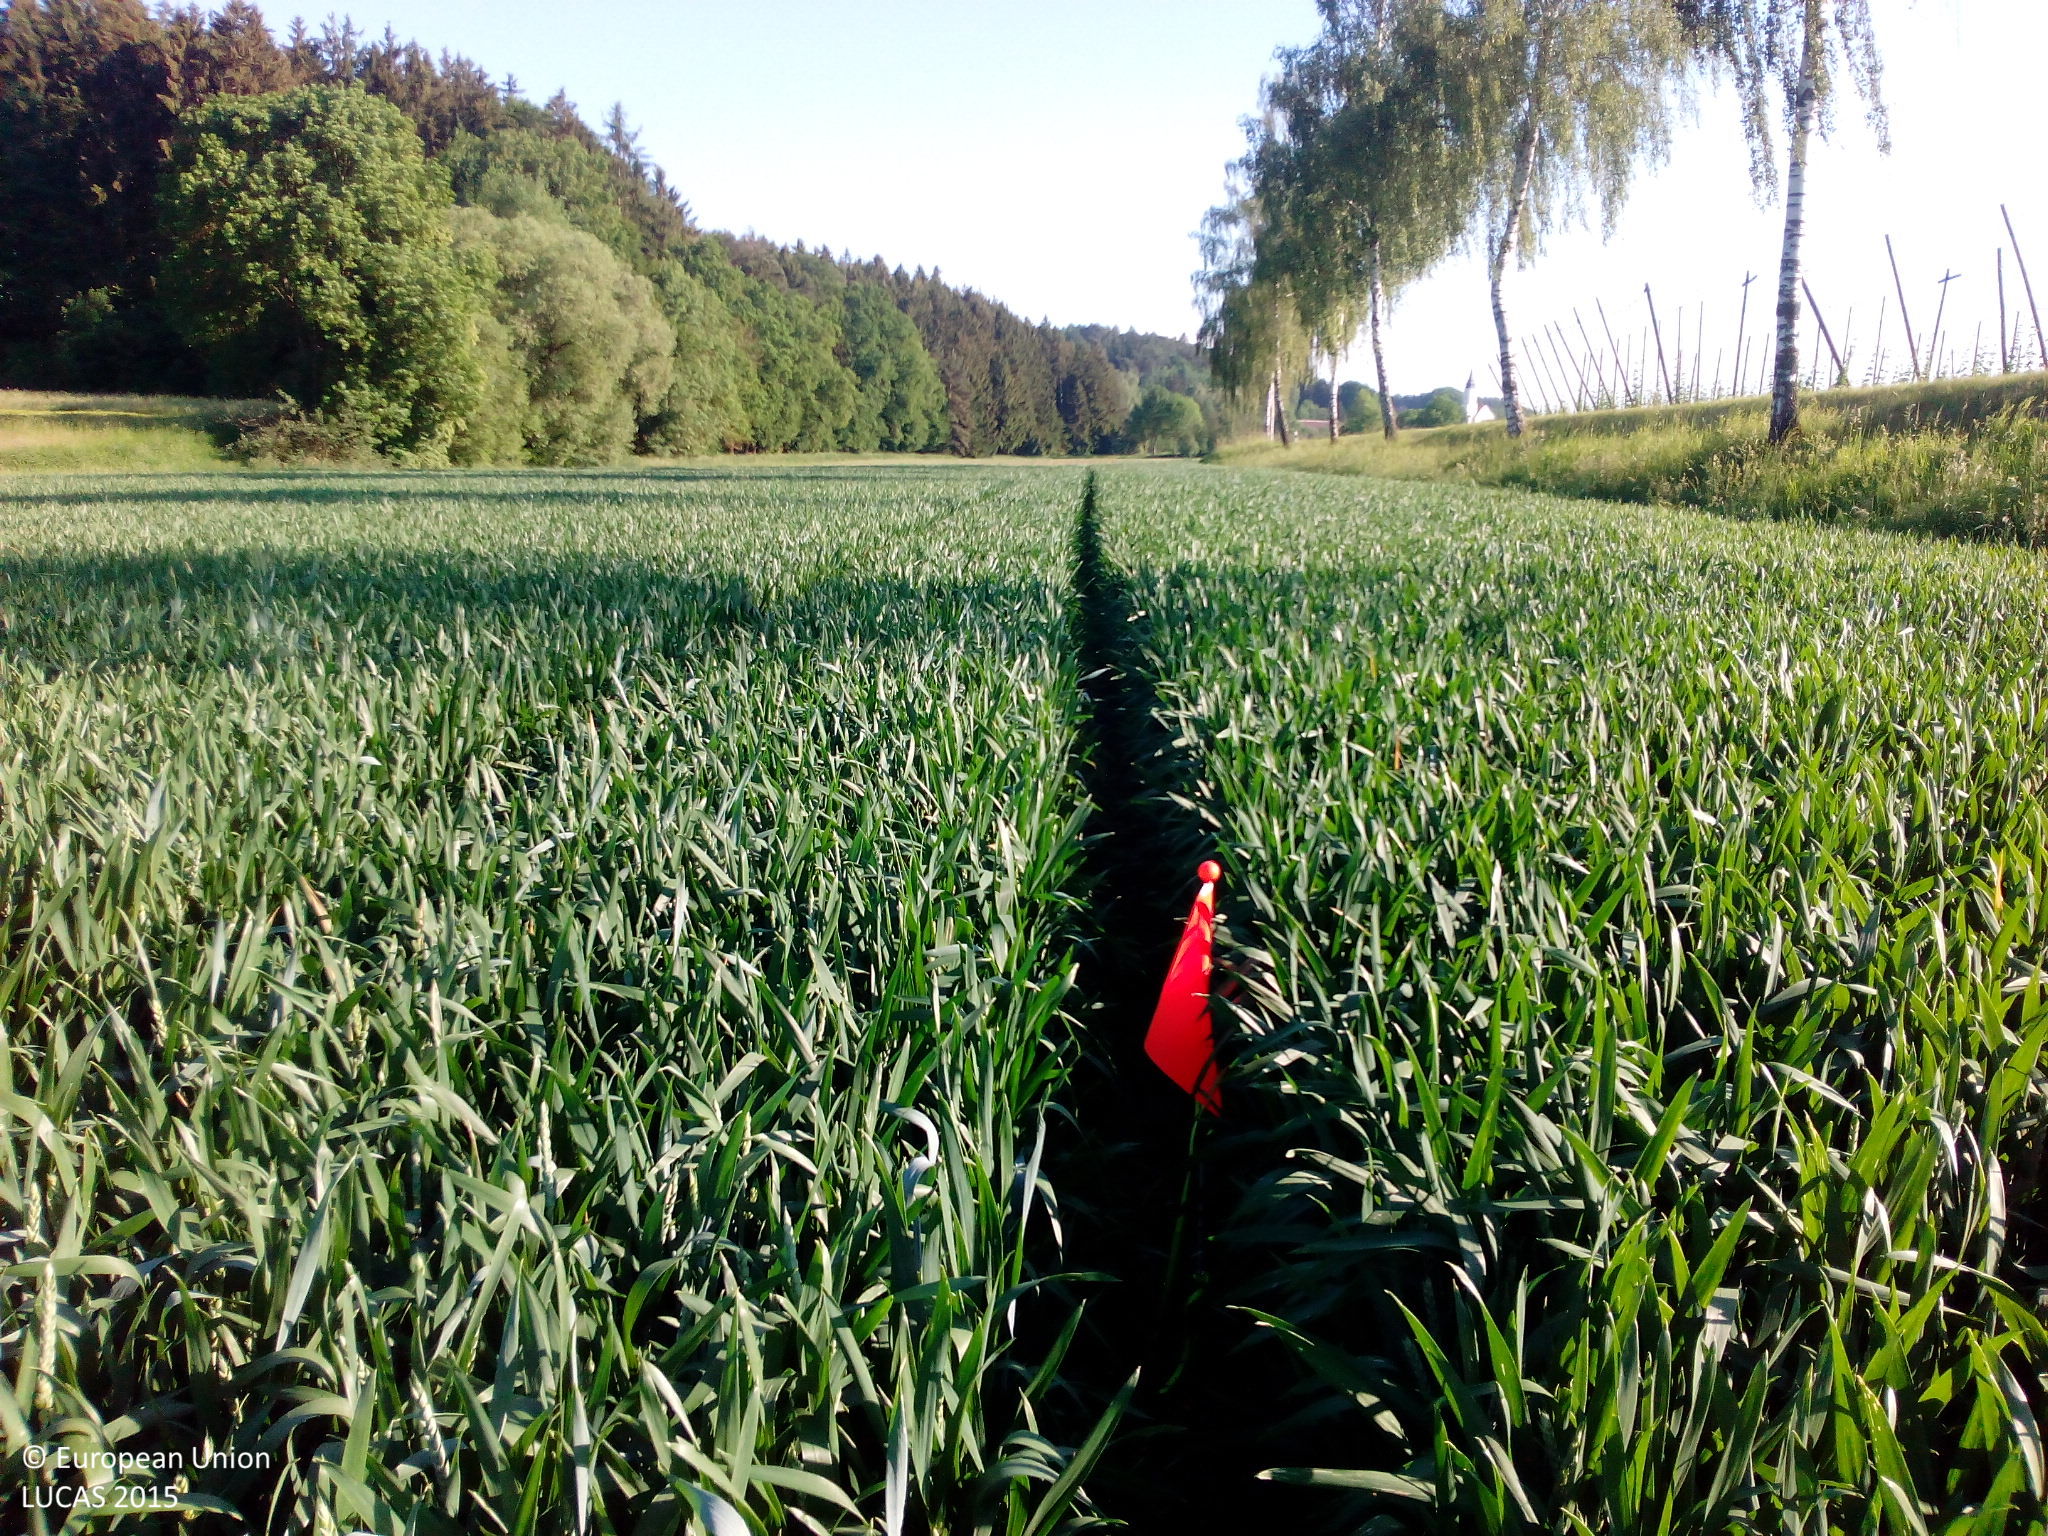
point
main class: Cropland
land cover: Common wheat
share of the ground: > 75 %
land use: Agriculture (excluding fallow land and kitchen gardens)
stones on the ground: < 10 %
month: June
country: DE
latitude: 48.6389
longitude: 11.9127
